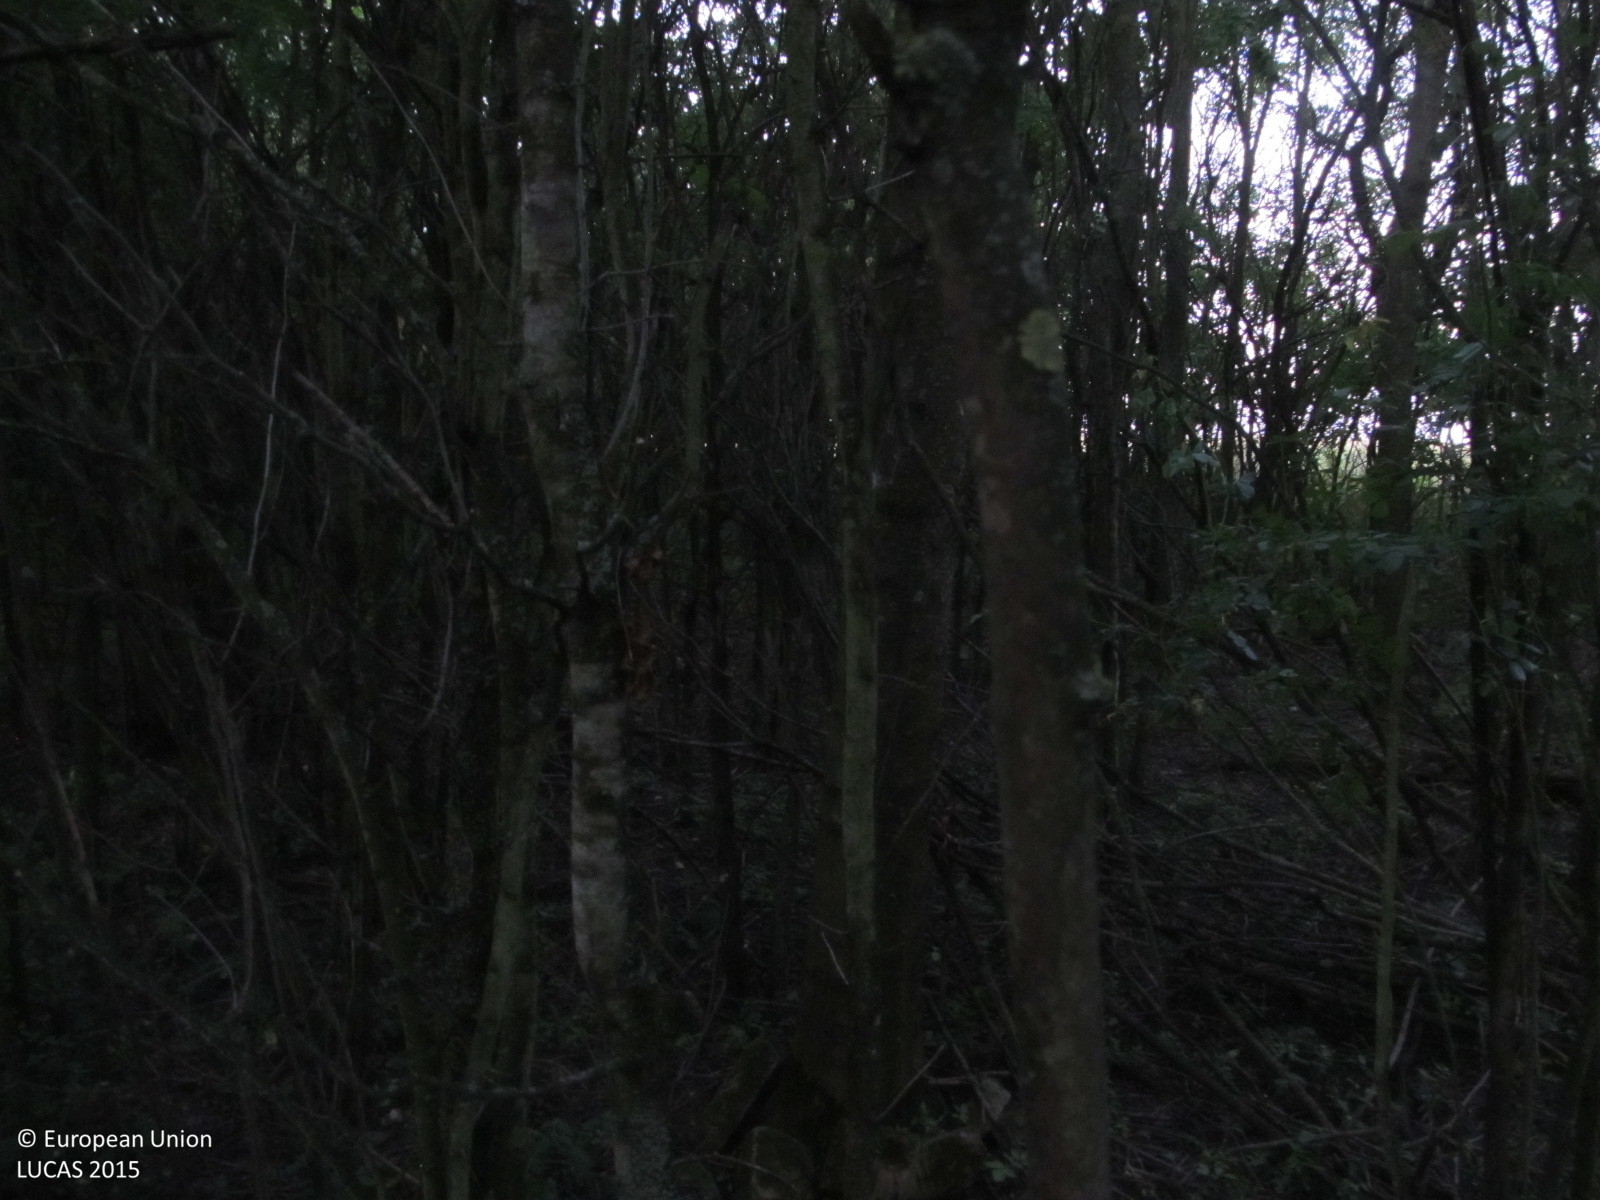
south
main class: Woodland
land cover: Broadleaved woodland
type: mesophytic deciduous forest
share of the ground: > 75 %
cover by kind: broadleaved forest trees 90 %, herbaceous plants 10 %
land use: Forestry
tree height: > 5 m
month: July
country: AT
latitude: 48.6976
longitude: 15.8872
